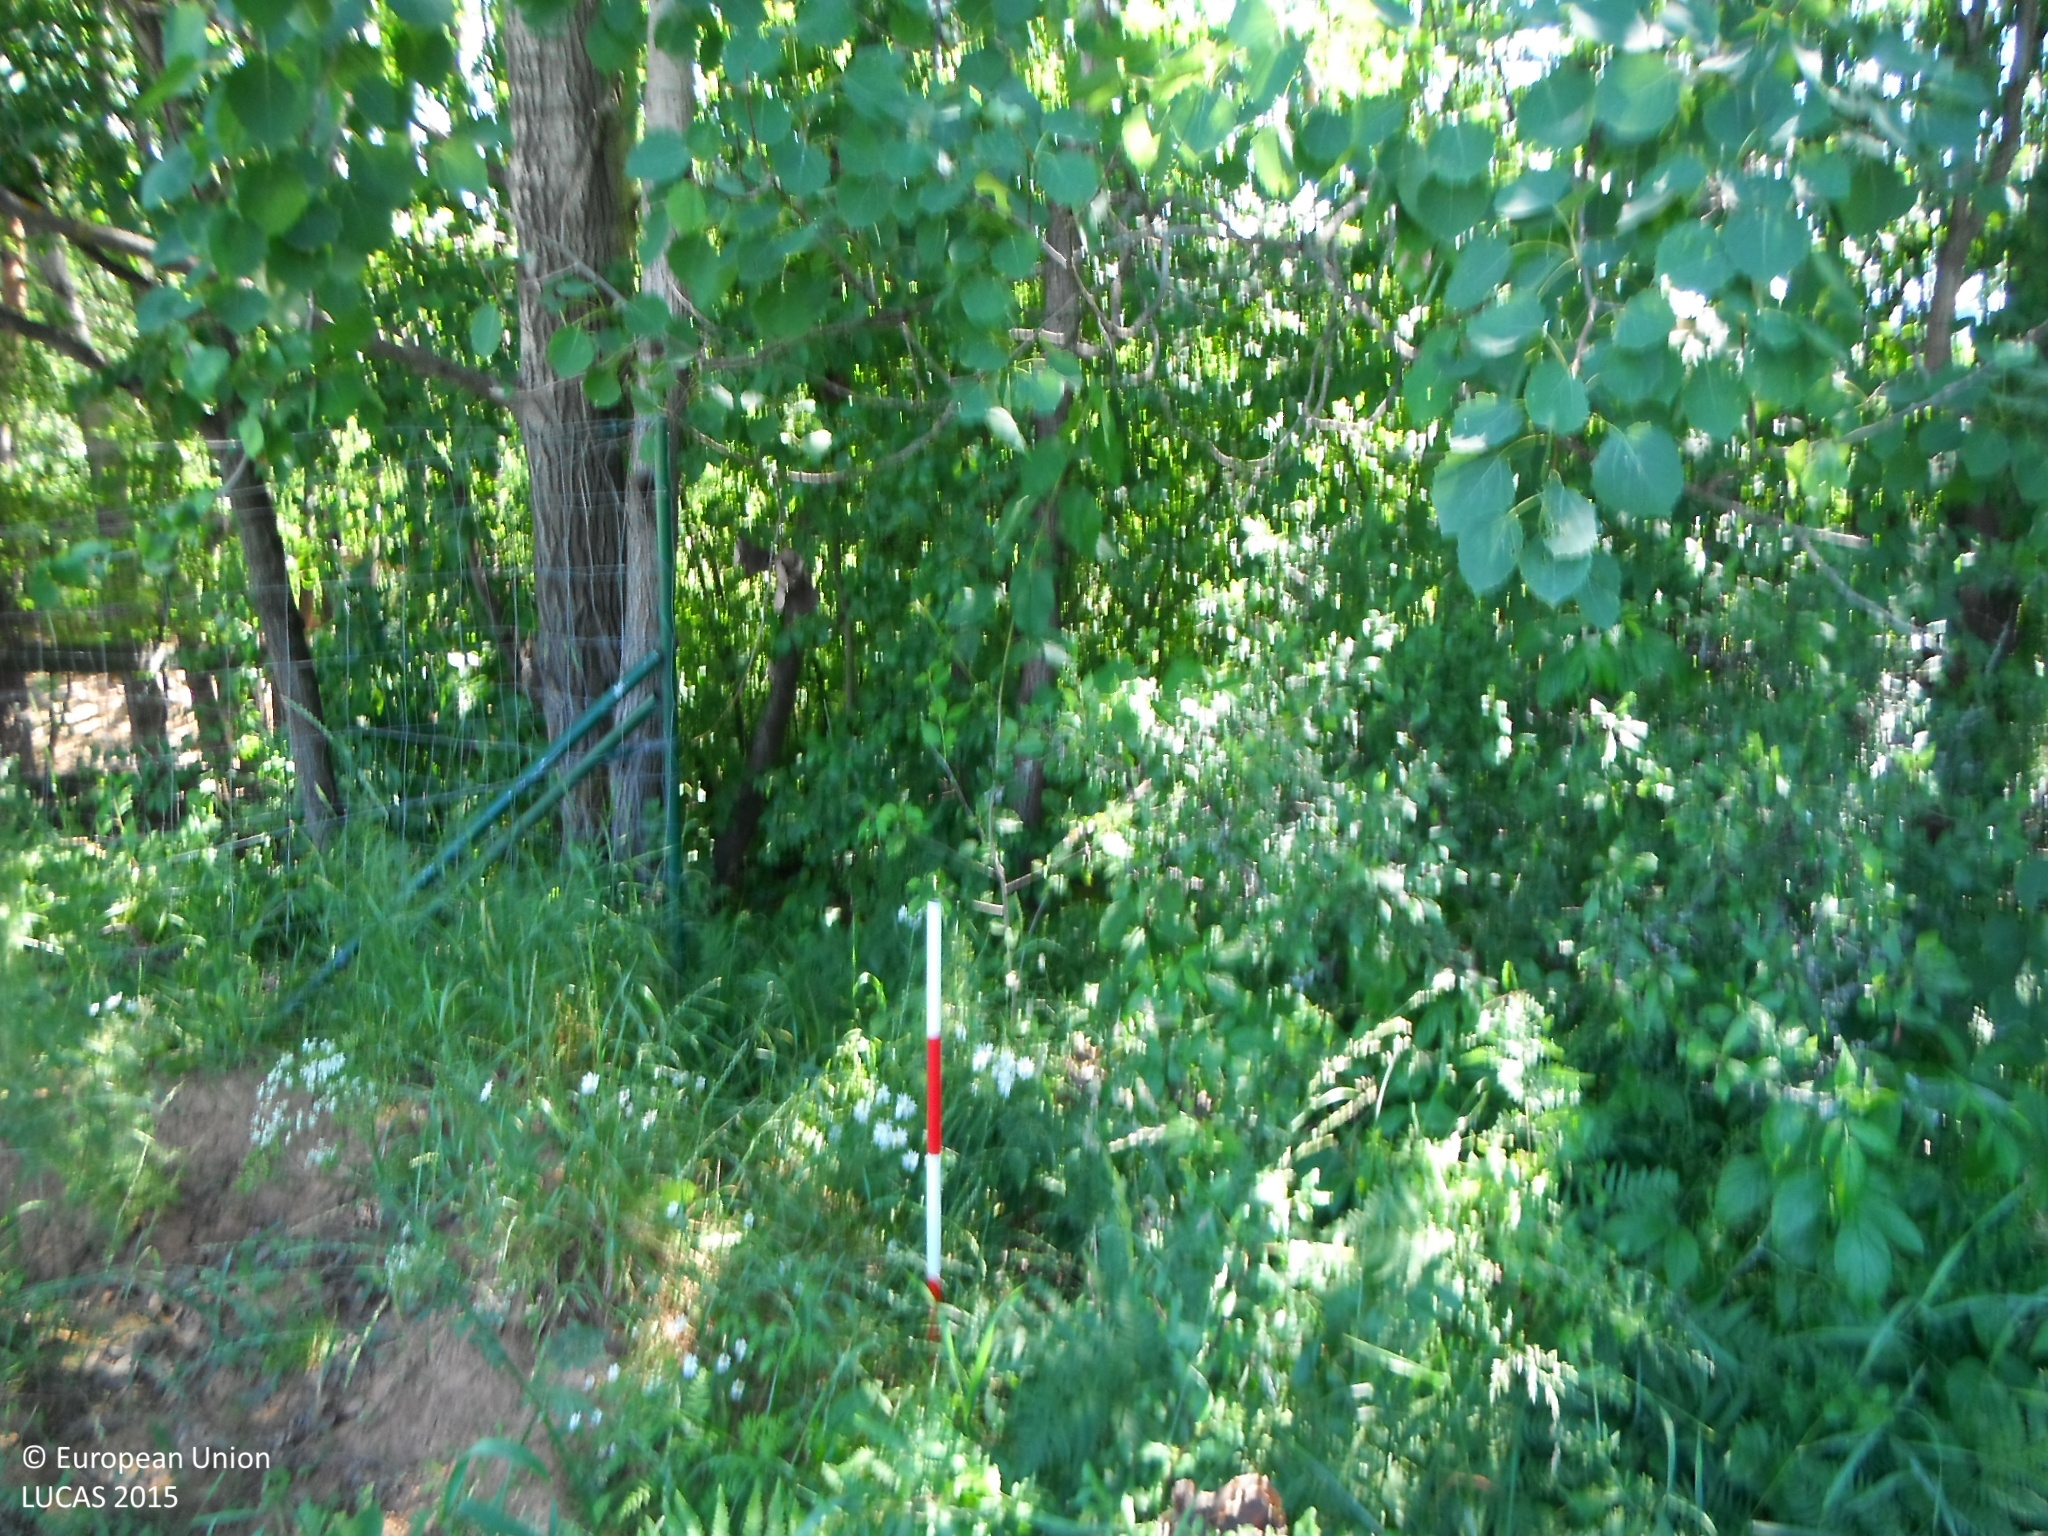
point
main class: Woodland
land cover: Broadleaved woodland
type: mesophytic deciduous forest
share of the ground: 50 - 75 %
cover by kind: broadleaved forest trees 60 %, herbaceous plants 40 %
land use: Forestry
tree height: > 5 m
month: July
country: SK
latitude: 48.9201
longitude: 20.6688
